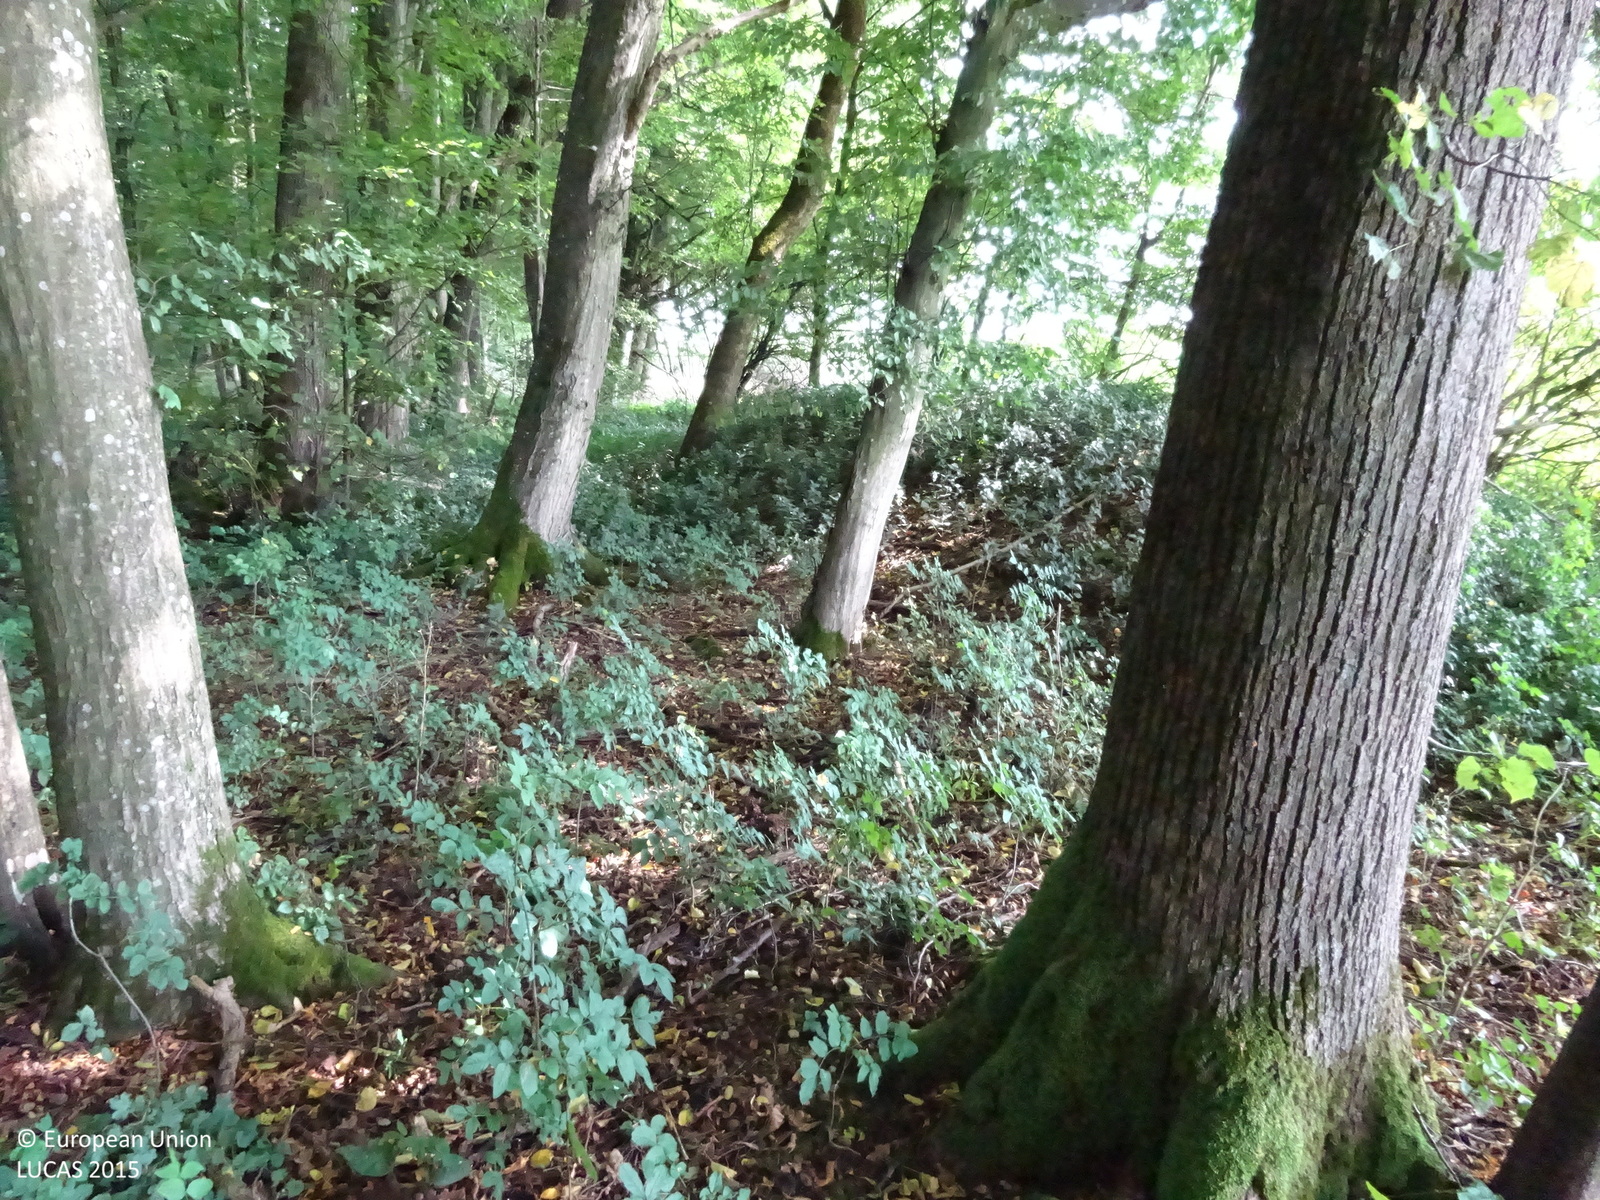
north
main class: Woodland
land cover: Broadleaved woodland
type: hemiboreal forest and nemoral coniferous forest and mixed broadleaved-coniferous forest
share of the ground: > 75 %
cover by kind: broadleaved forest trees 100 %
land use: Forestry
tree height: > 5 m
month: July
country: AT
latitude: 46.9149
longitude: 15.4749
